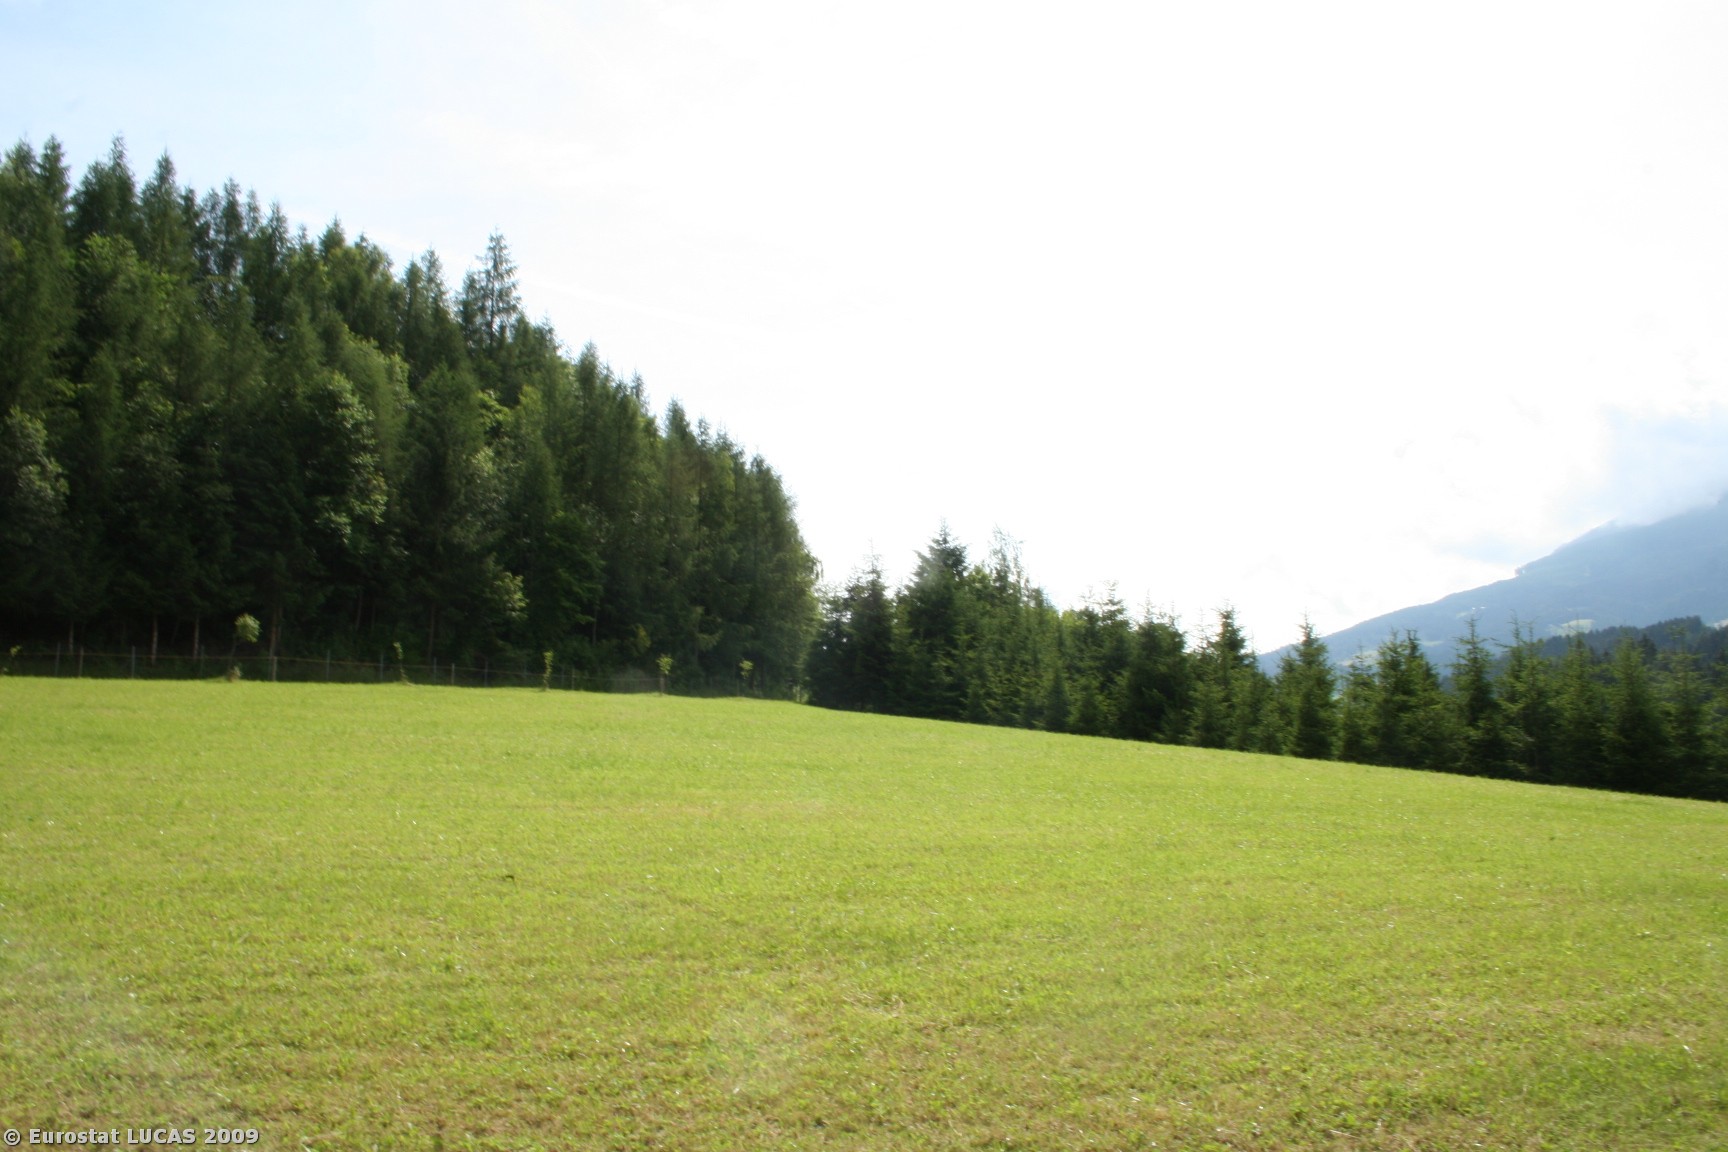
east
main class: Grassland
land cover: Grassland without tree/shrub cover
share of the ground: > 75 %
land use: Agriculture (excluding fallow land and kitchen gardens)
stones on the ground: < 10 %
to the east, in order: Grassland without tree/shrub cover; Fences; Paved roads, cycling and walking lanes; Coniferous woodland; Fences; Mixed woodland; Shrubland with sparse tree cover; Fences; Paved roads, cycling and walking lanes
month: June
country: AT
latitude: 47.4380
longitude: 13.2203
